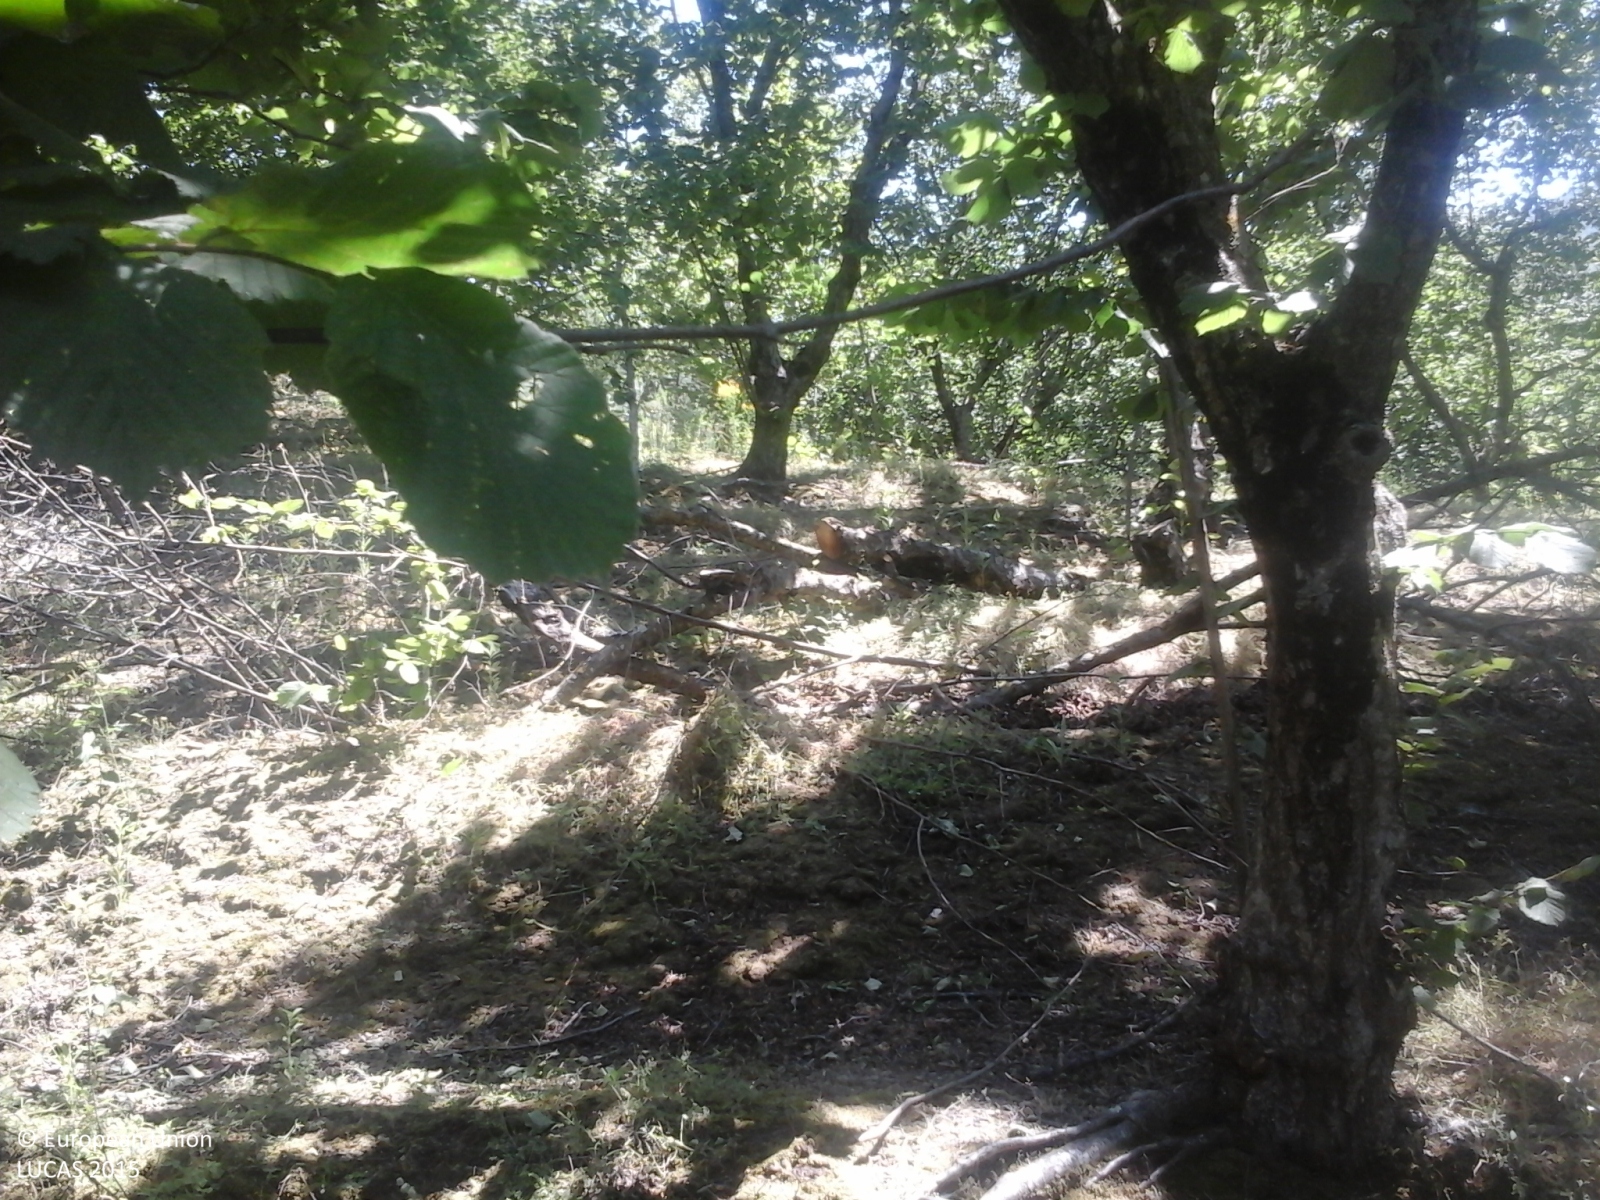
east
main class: Cropland
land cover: Nuts trees
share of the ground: > 75 %
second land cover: Spontaneously vegetated surfaces
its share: > 75 %
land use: Agriculture (excluding fallow land and kitchen gardens)
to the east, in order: Nuts trees; Spontaneously vegetated surfaces; Broadleaved woodland; Ditches and canals; Broadleaved woodland
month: July
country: IT
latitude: 40.8991
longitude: 14.6700
